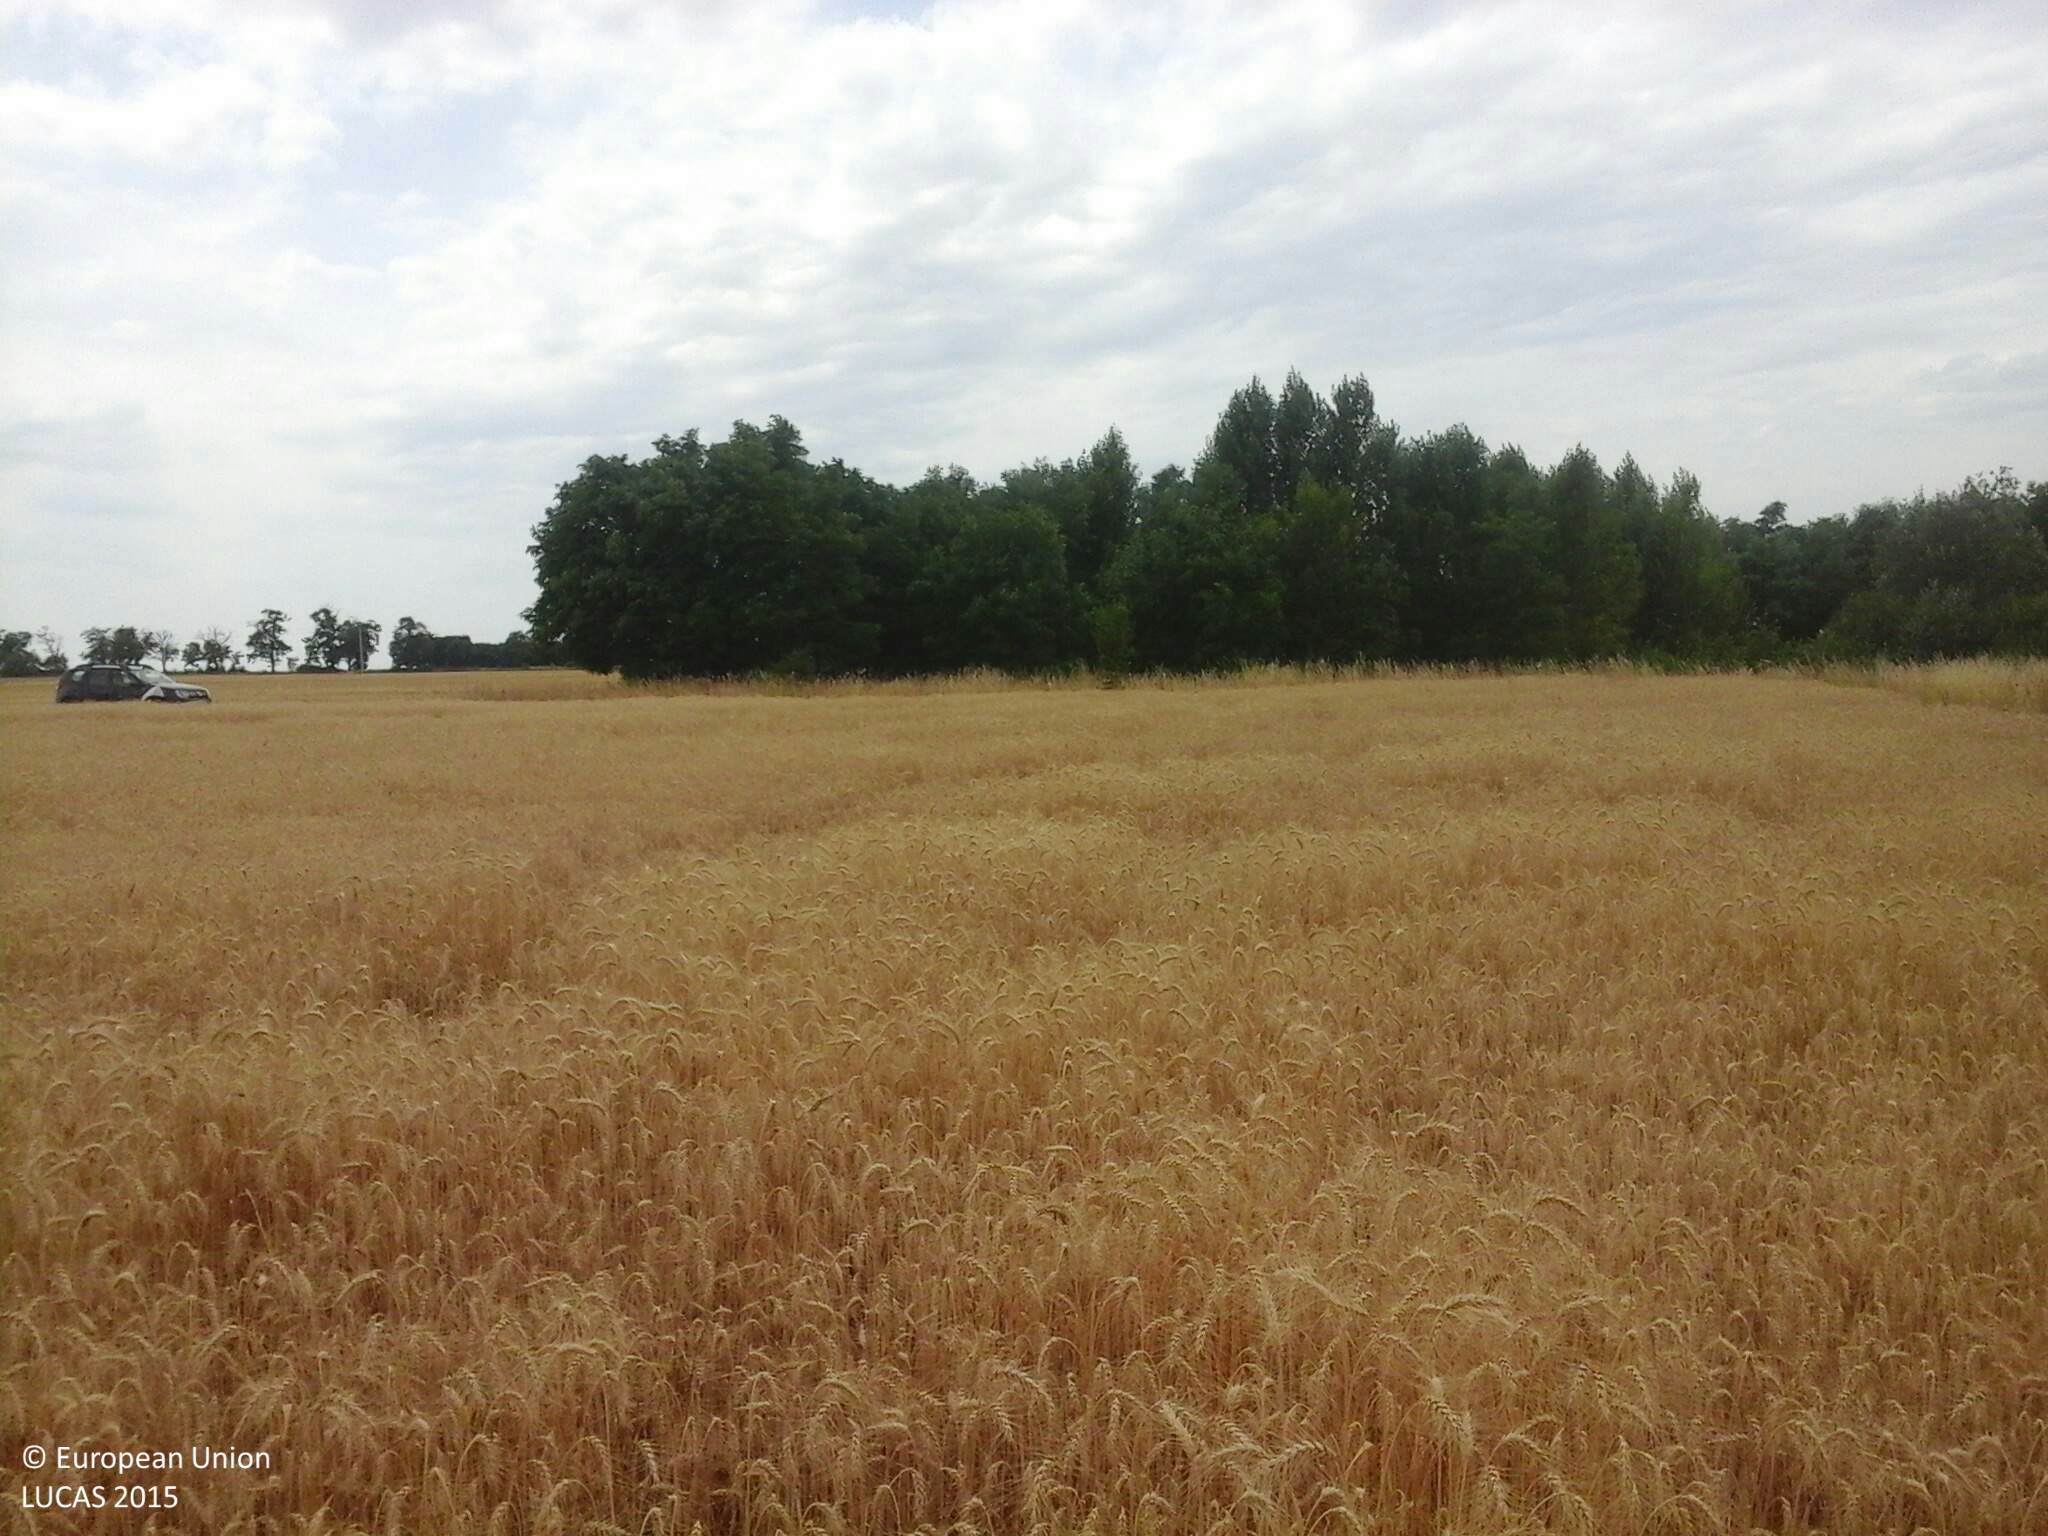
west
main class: Cropland
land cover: Common wheat
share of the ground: > 75 %
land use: Agriculture (excluding fallow land and kitchen gardens)
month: July
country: HU
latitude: 47.2629
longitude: 17.2352
